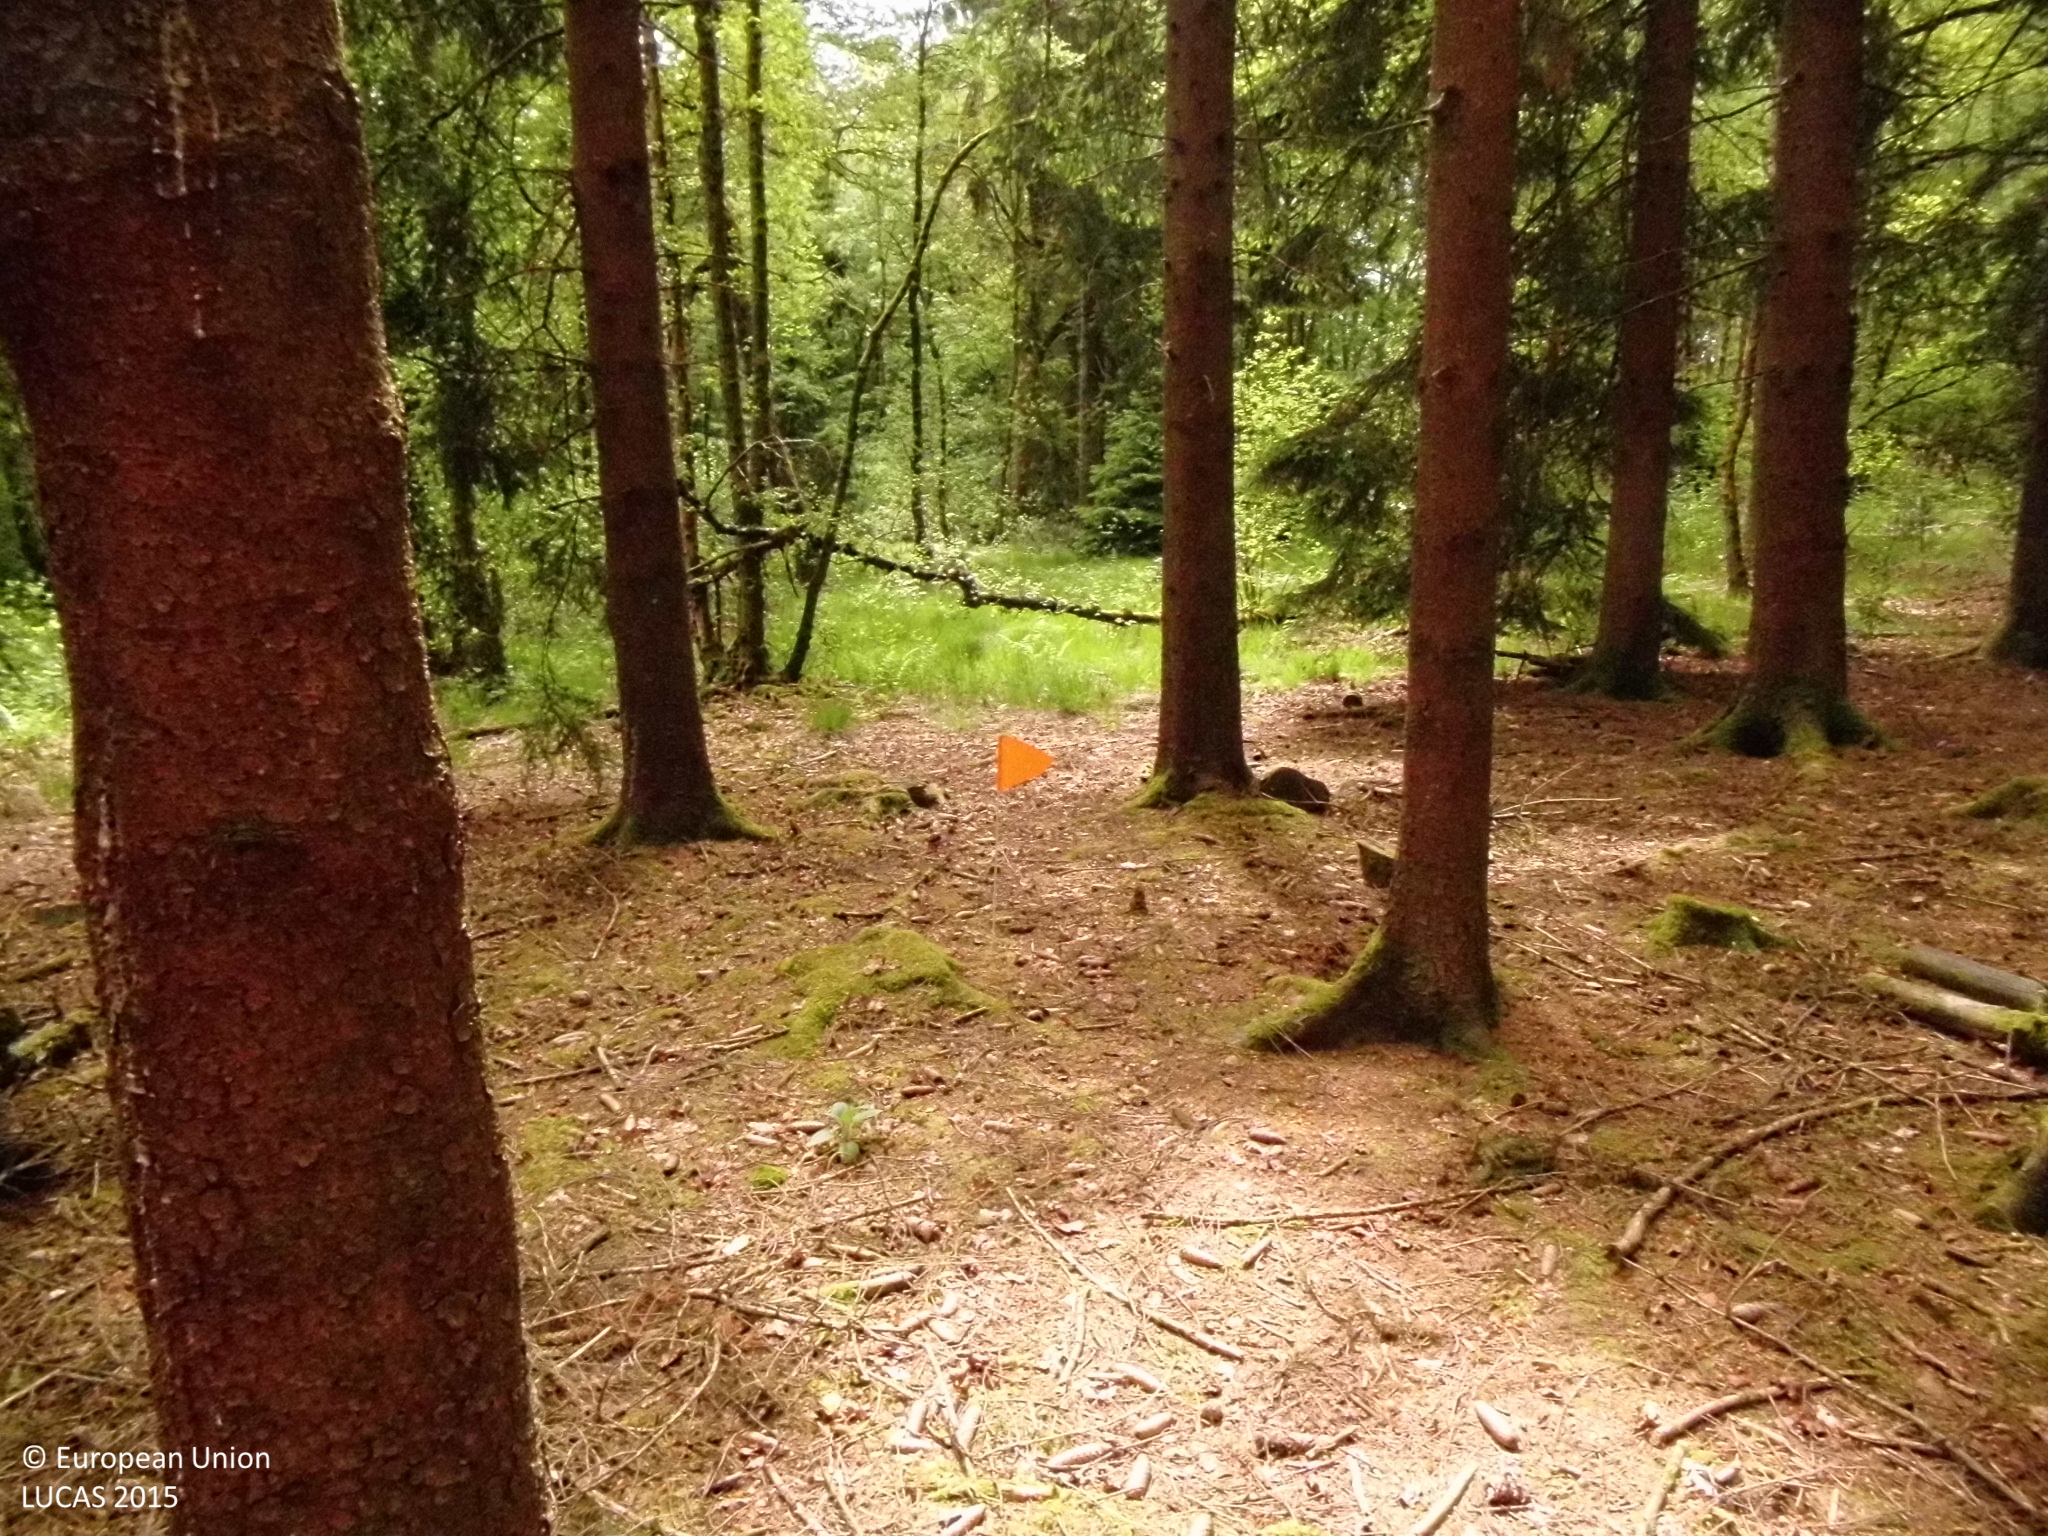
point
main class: Woodland
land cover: Spruce dominated coniferous woodland
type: hemiboreal forest and nemoral coniferous forest and mixed broadleaved-coniferous forest
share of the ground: > 75 %
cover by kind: coniferous forest trees 80 %, unconsolidated bare surface 15 %, herbaceous plants 5 %
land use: Forestry
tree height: > 5 m
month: May
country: DE
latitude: 50.9306
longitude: 7.5103
